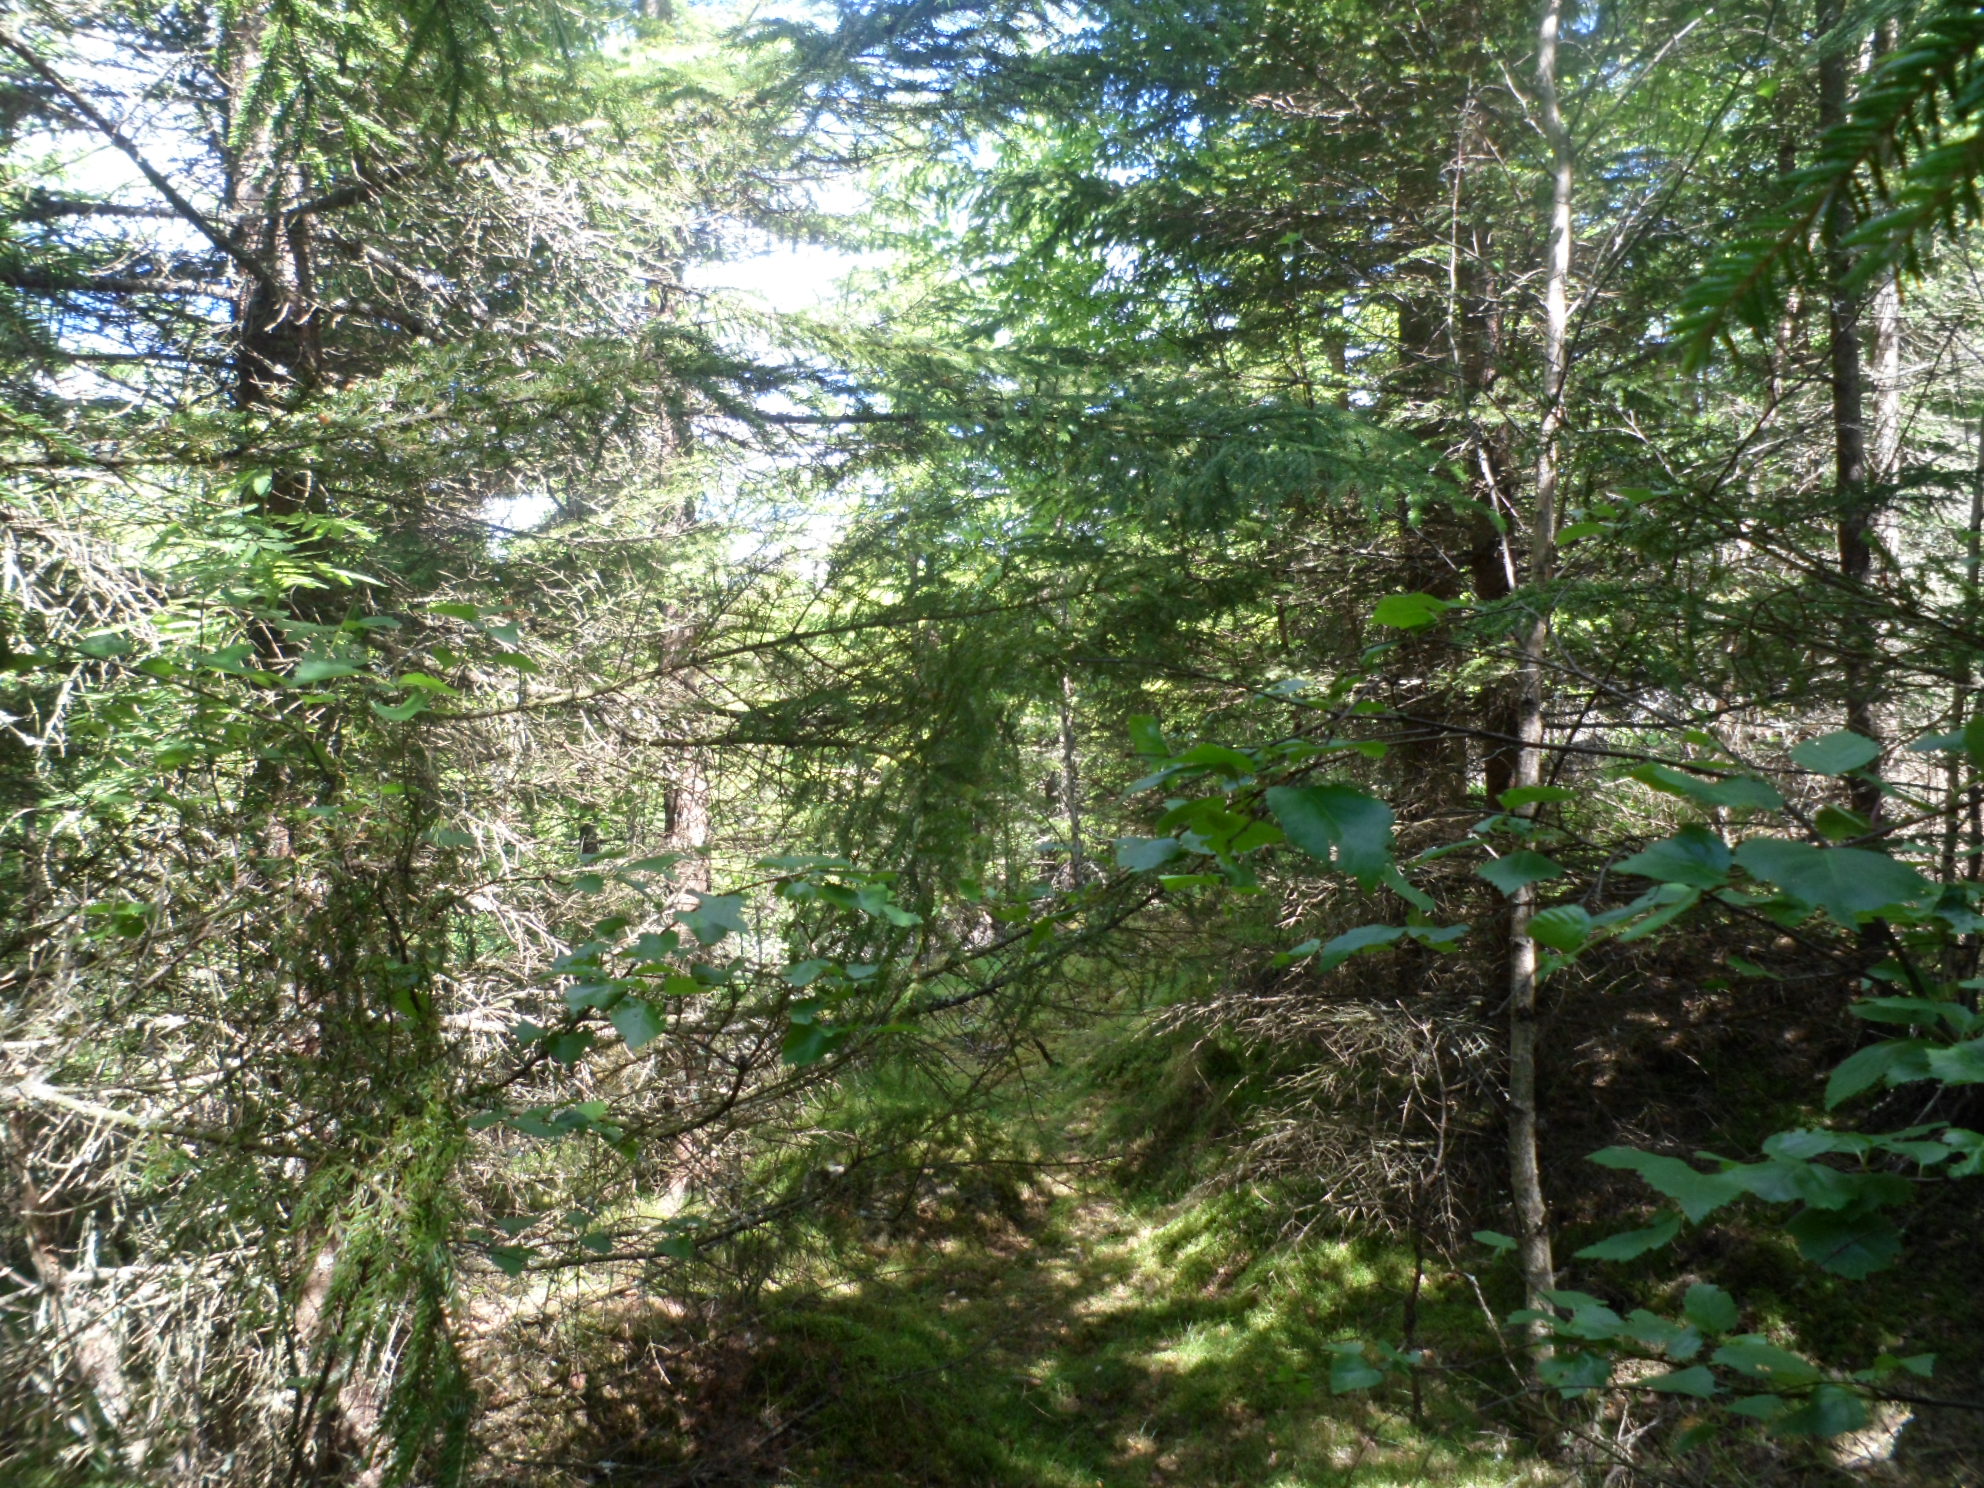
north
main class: Woodland
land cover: Spruce dominated coniferous woodland
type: boreal forest
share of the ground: > 75 %
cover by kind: coniferous forest trees 75 %, lichens and mosses 10 %, broadleaved forest trees 5 %, shrubs 5 %, herbaceous plants 5 %
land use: Forestry
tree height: > 5 m
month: July
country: SE
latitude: 57.4043
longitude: 14.5396
